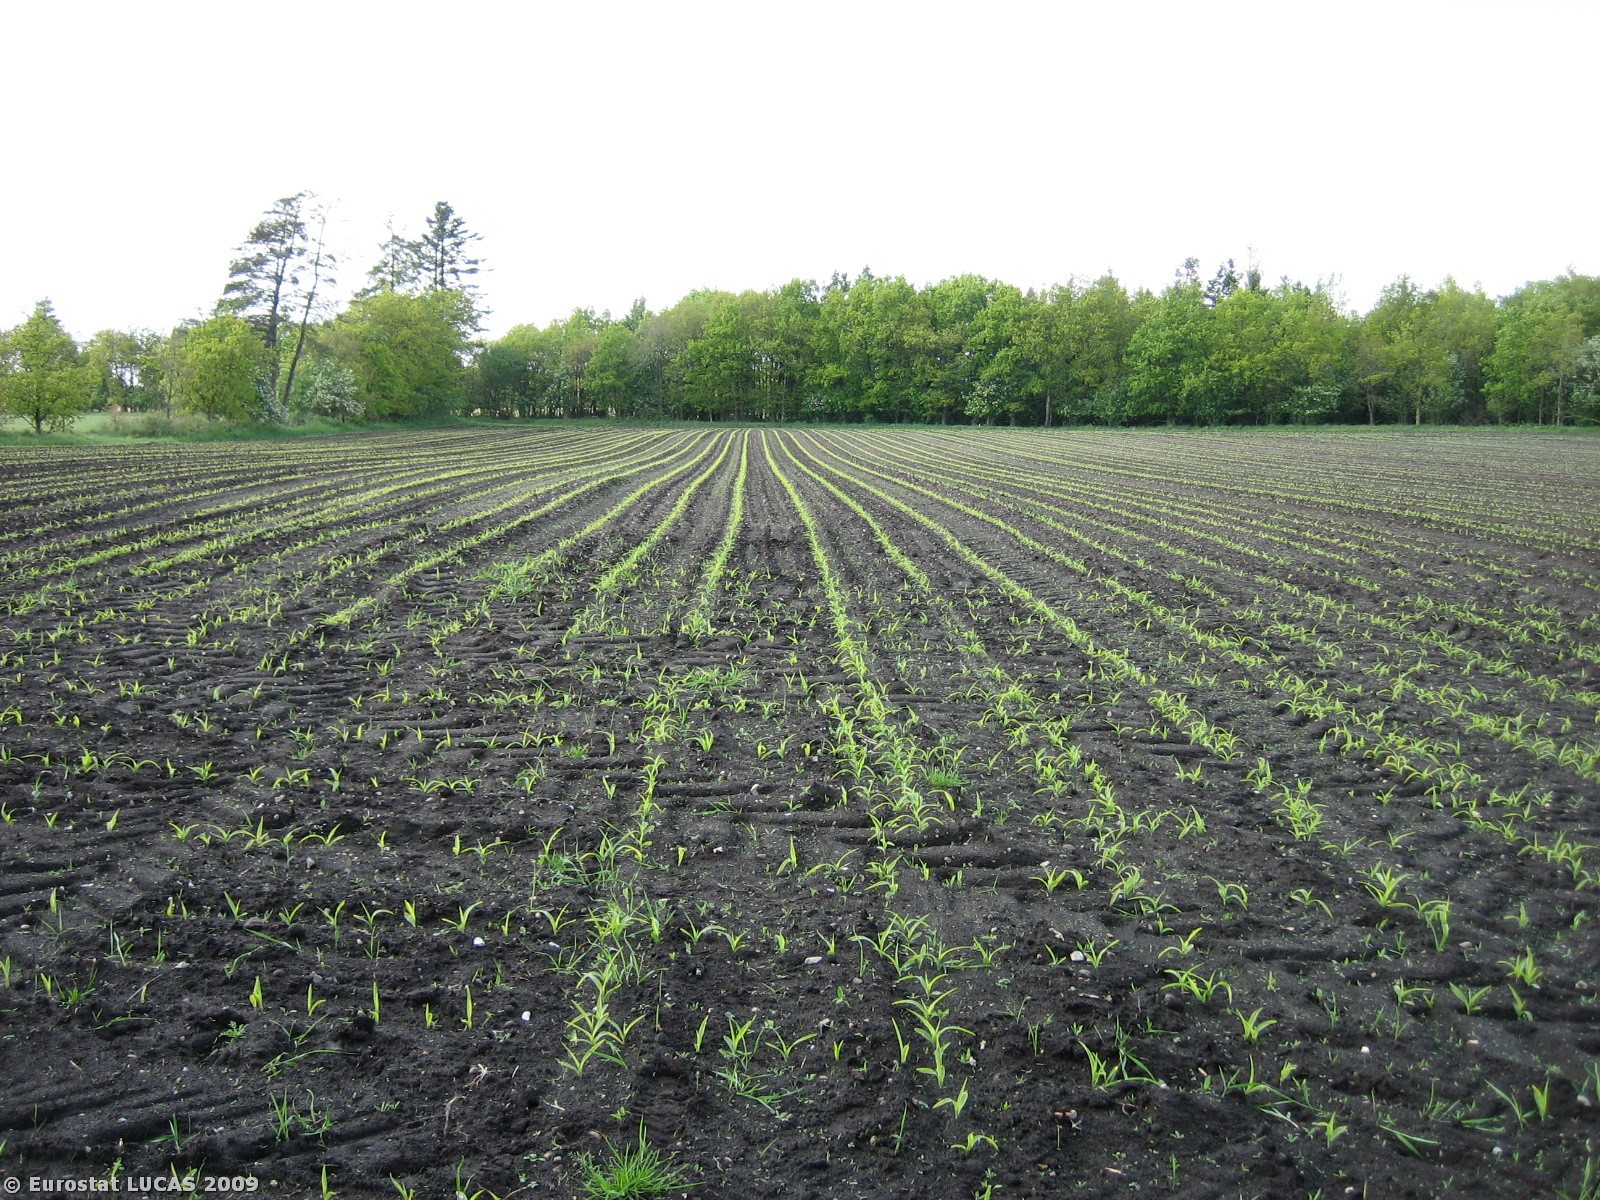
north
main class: Cropland
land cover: Maize
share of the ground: < 10 %
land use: Agriculture (excluding fallow land and kitchen gardens)
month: May
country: DK
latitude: 56.2354
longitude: 8.7270
